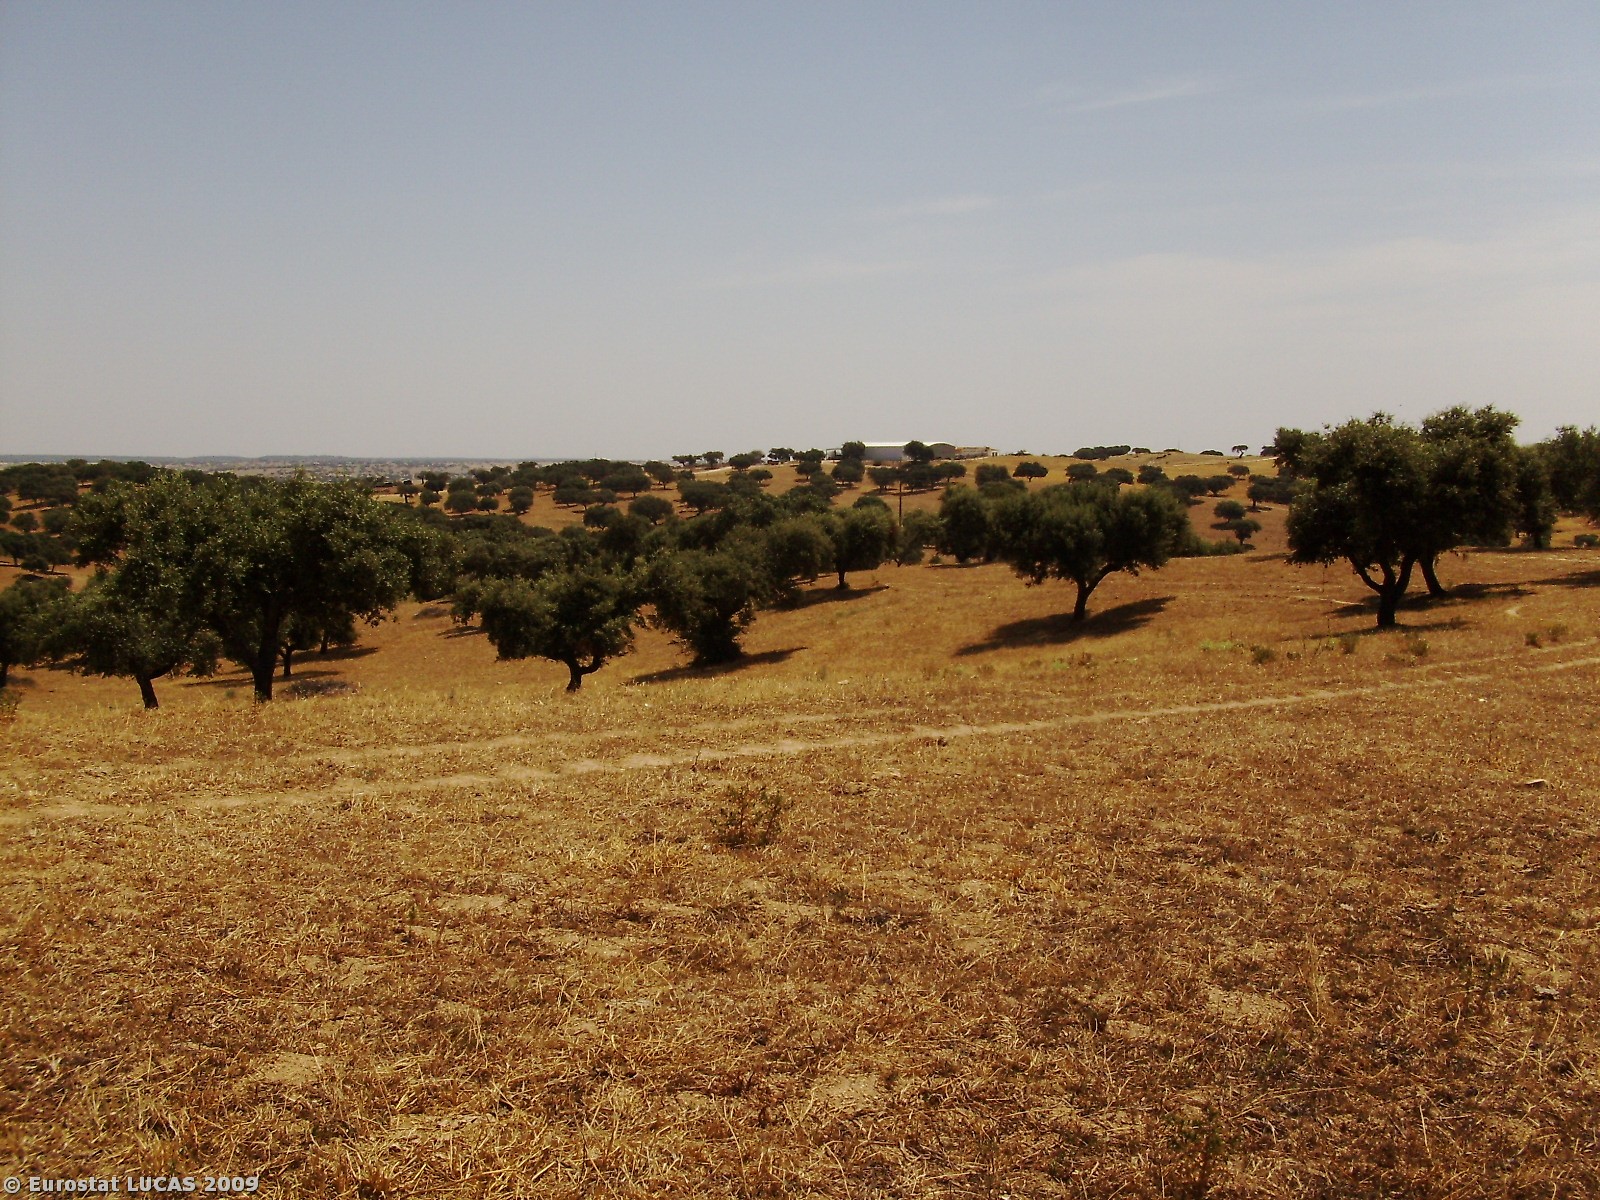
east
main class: Grassland
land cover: Grassland without tree/shrub cover
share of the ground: > 75 %
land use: Agriculture (excluding fallow land and kitchen gardens)
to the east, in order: Grassland without tree/shrub cover; Tracks; Grassland with sparse tree/shrub cover; Tracks; Broadleaved woodland
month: June
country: PT
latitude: 39.0873
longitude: -7.2951
